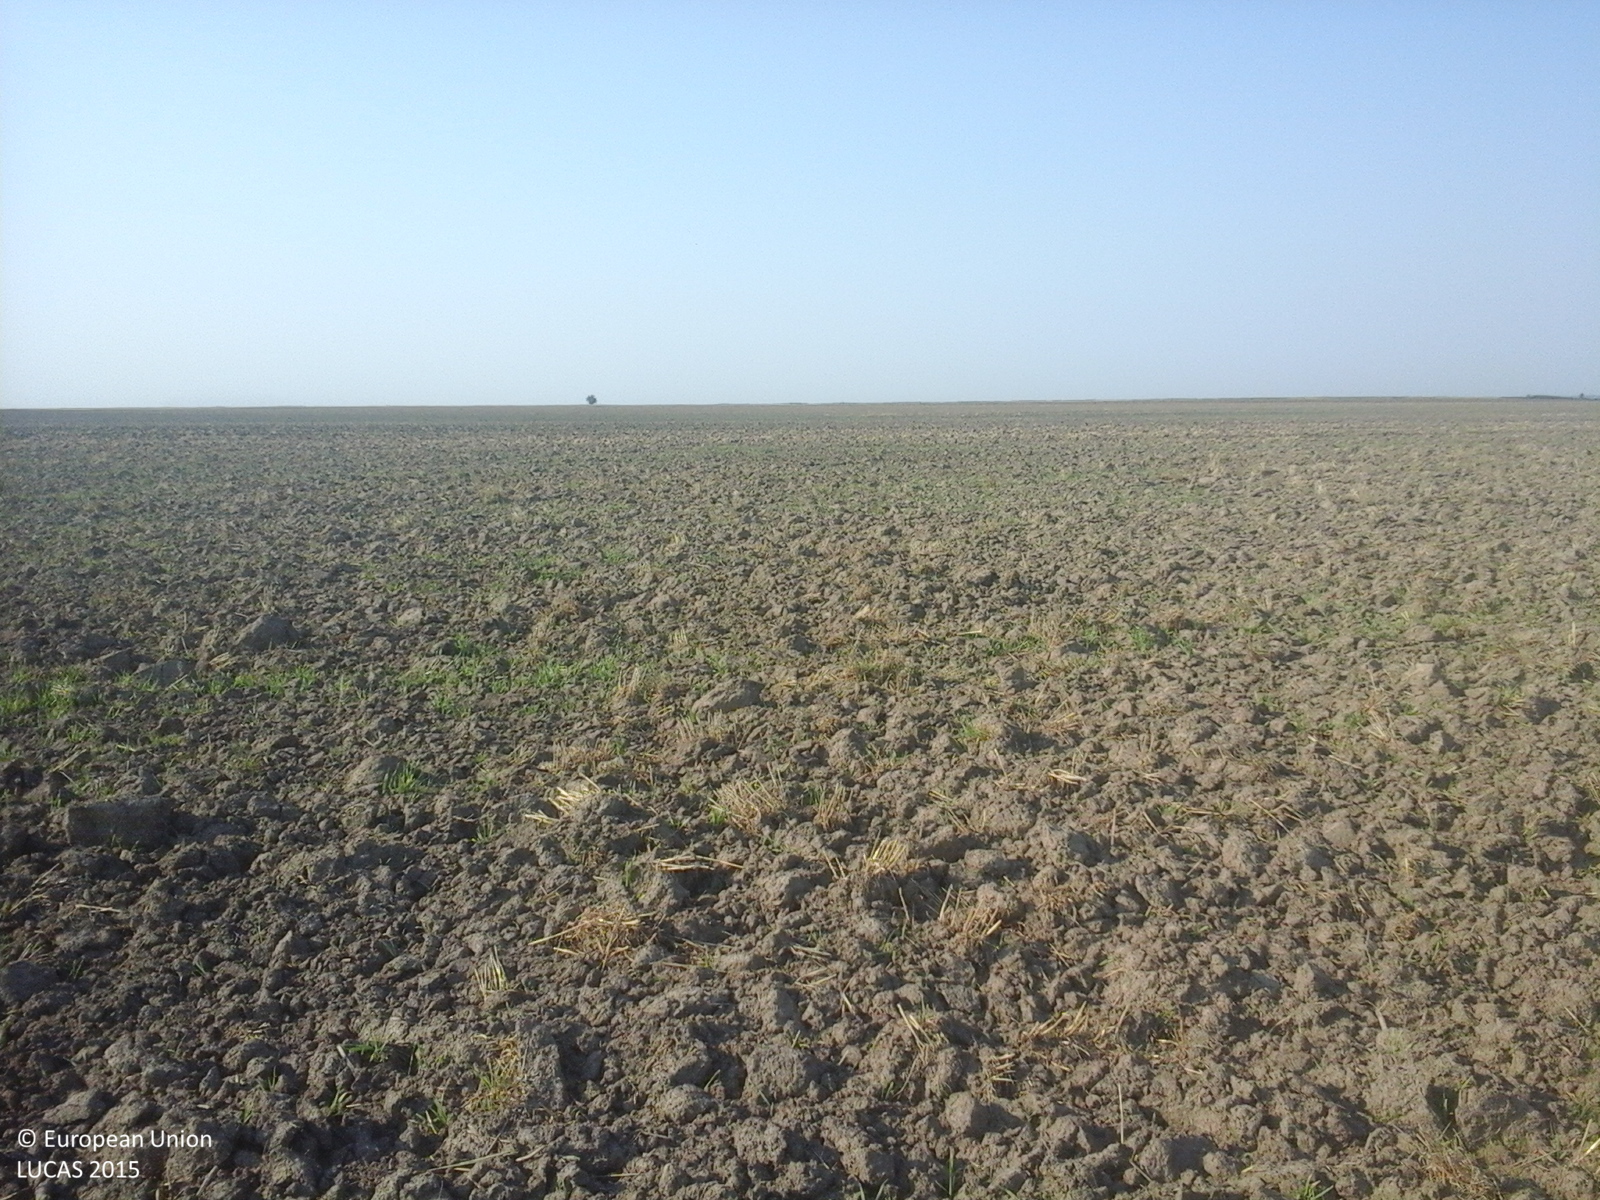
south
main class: Cropland
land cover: Rye
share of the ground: < 10 %
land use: Agriculture (excluding fallow land and kitchen gardens)
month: July
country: RO
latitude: 44.4977
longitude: 24.7527
